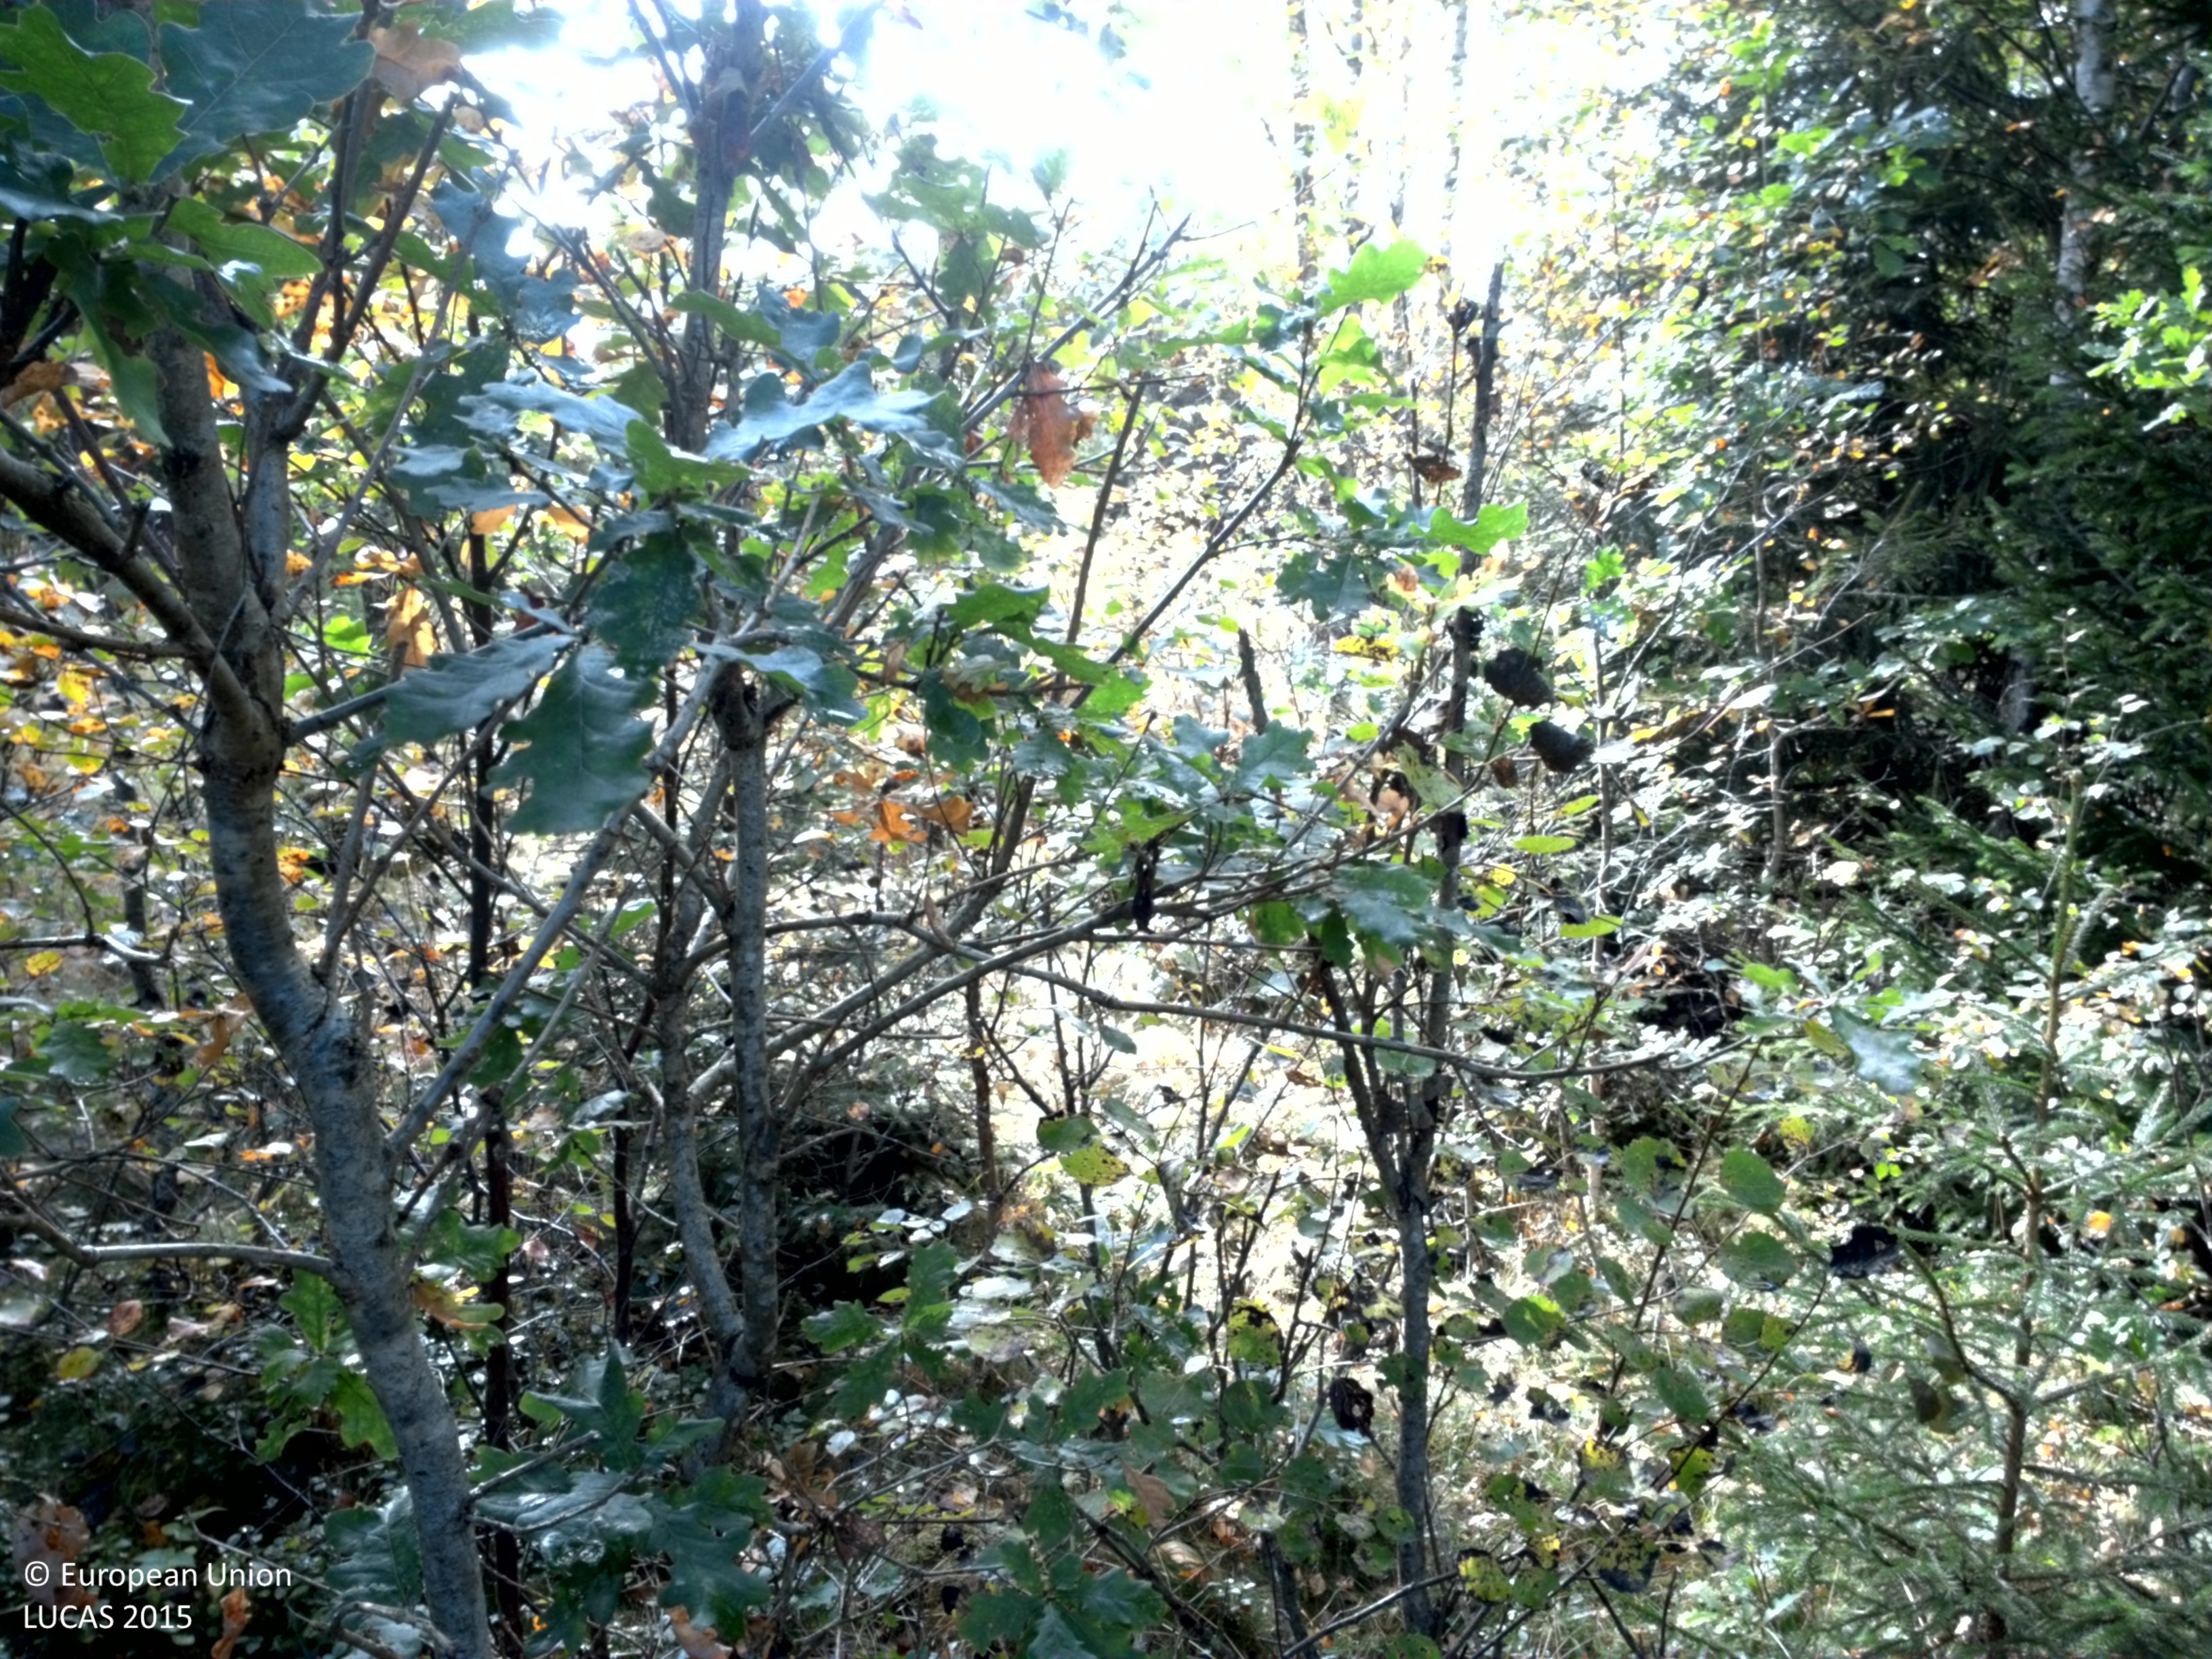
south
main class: Woodland
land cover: Broadleaved woodland
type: hemiboreal forest and nemoral coniferous forest and mixed broadleaved-coniferous forest
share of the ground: > 75 %
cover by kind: broadleaved forest trees 80 %, herbaceous plants 15 %, coniferous forest trees 5 %
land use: Forestry
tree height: > 5 m
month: September
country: SE
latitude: 58.0391
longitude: 13.1284
